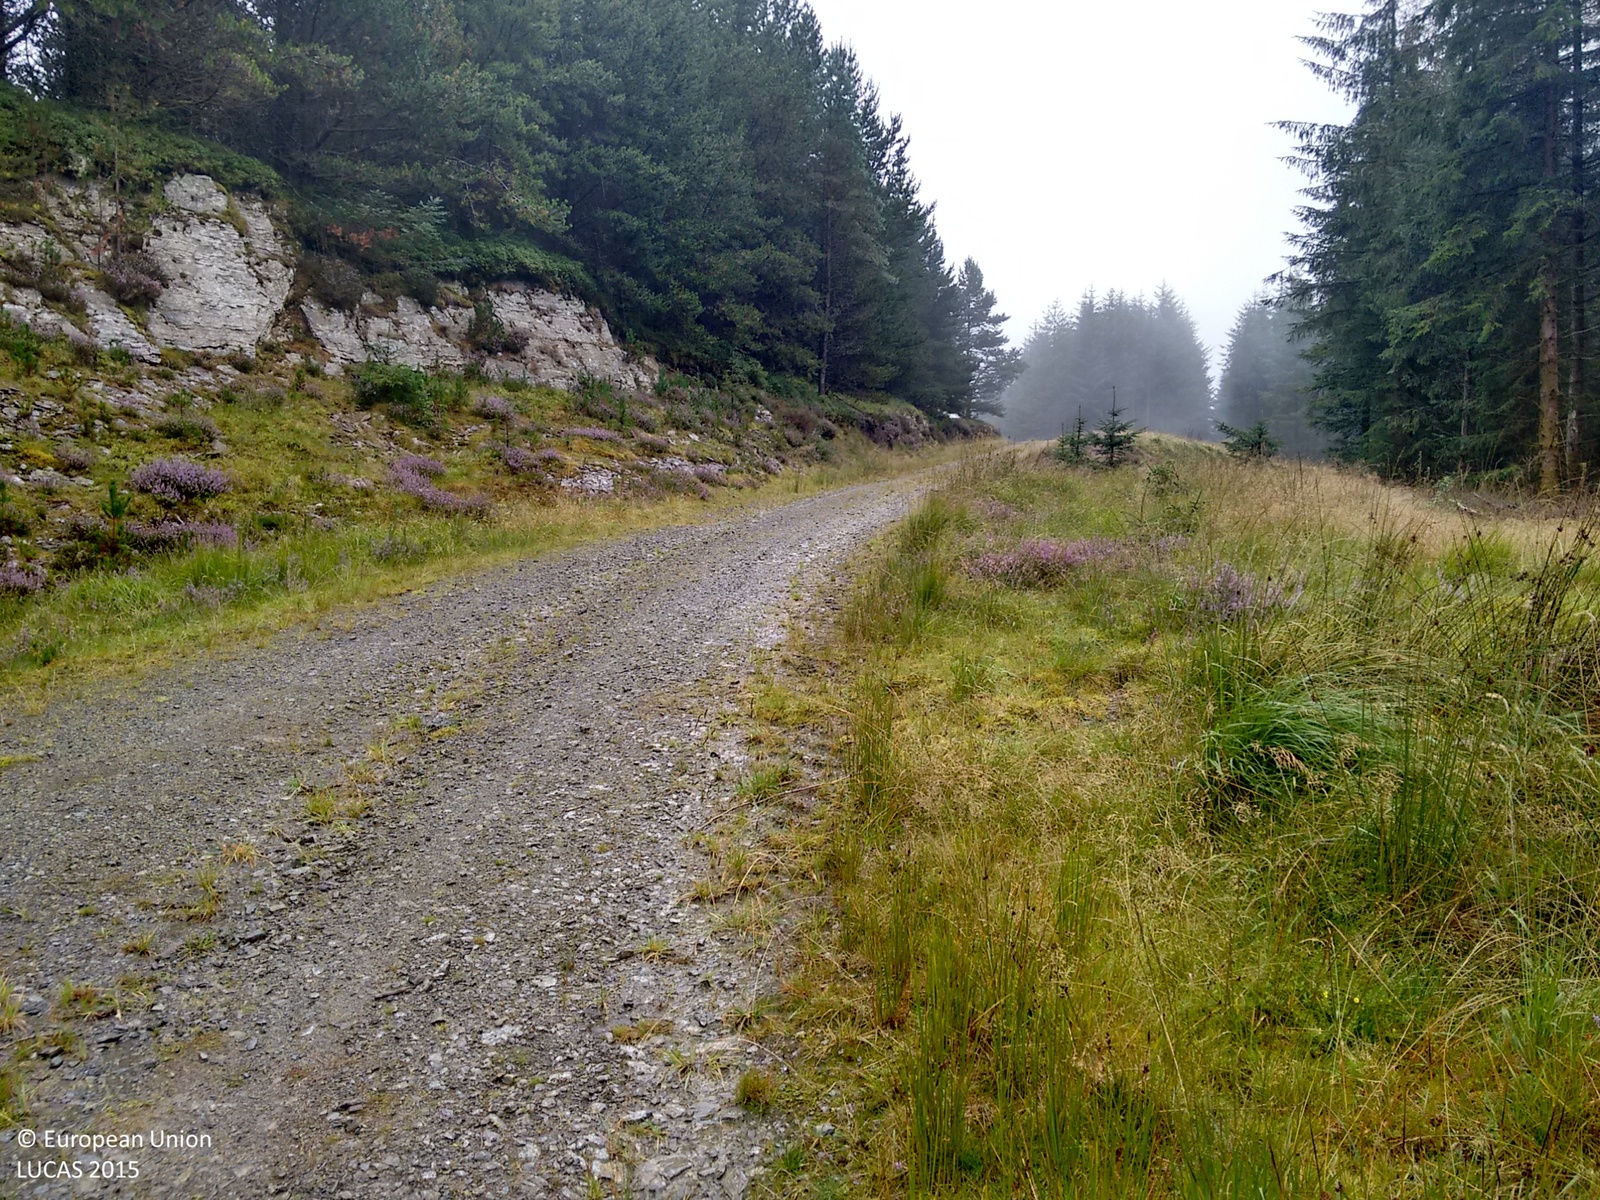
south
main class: Woodland
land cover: Spruce dominated coniferous woodland
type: exotic forest
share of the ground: > 75 %
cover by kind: coniferous forest trees 70 %, shrubs 15 %, herbaceous plants 15 %
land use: Forestry
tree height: > 5 m
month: September
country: GB
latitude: 52.1277
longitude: -3.8369
